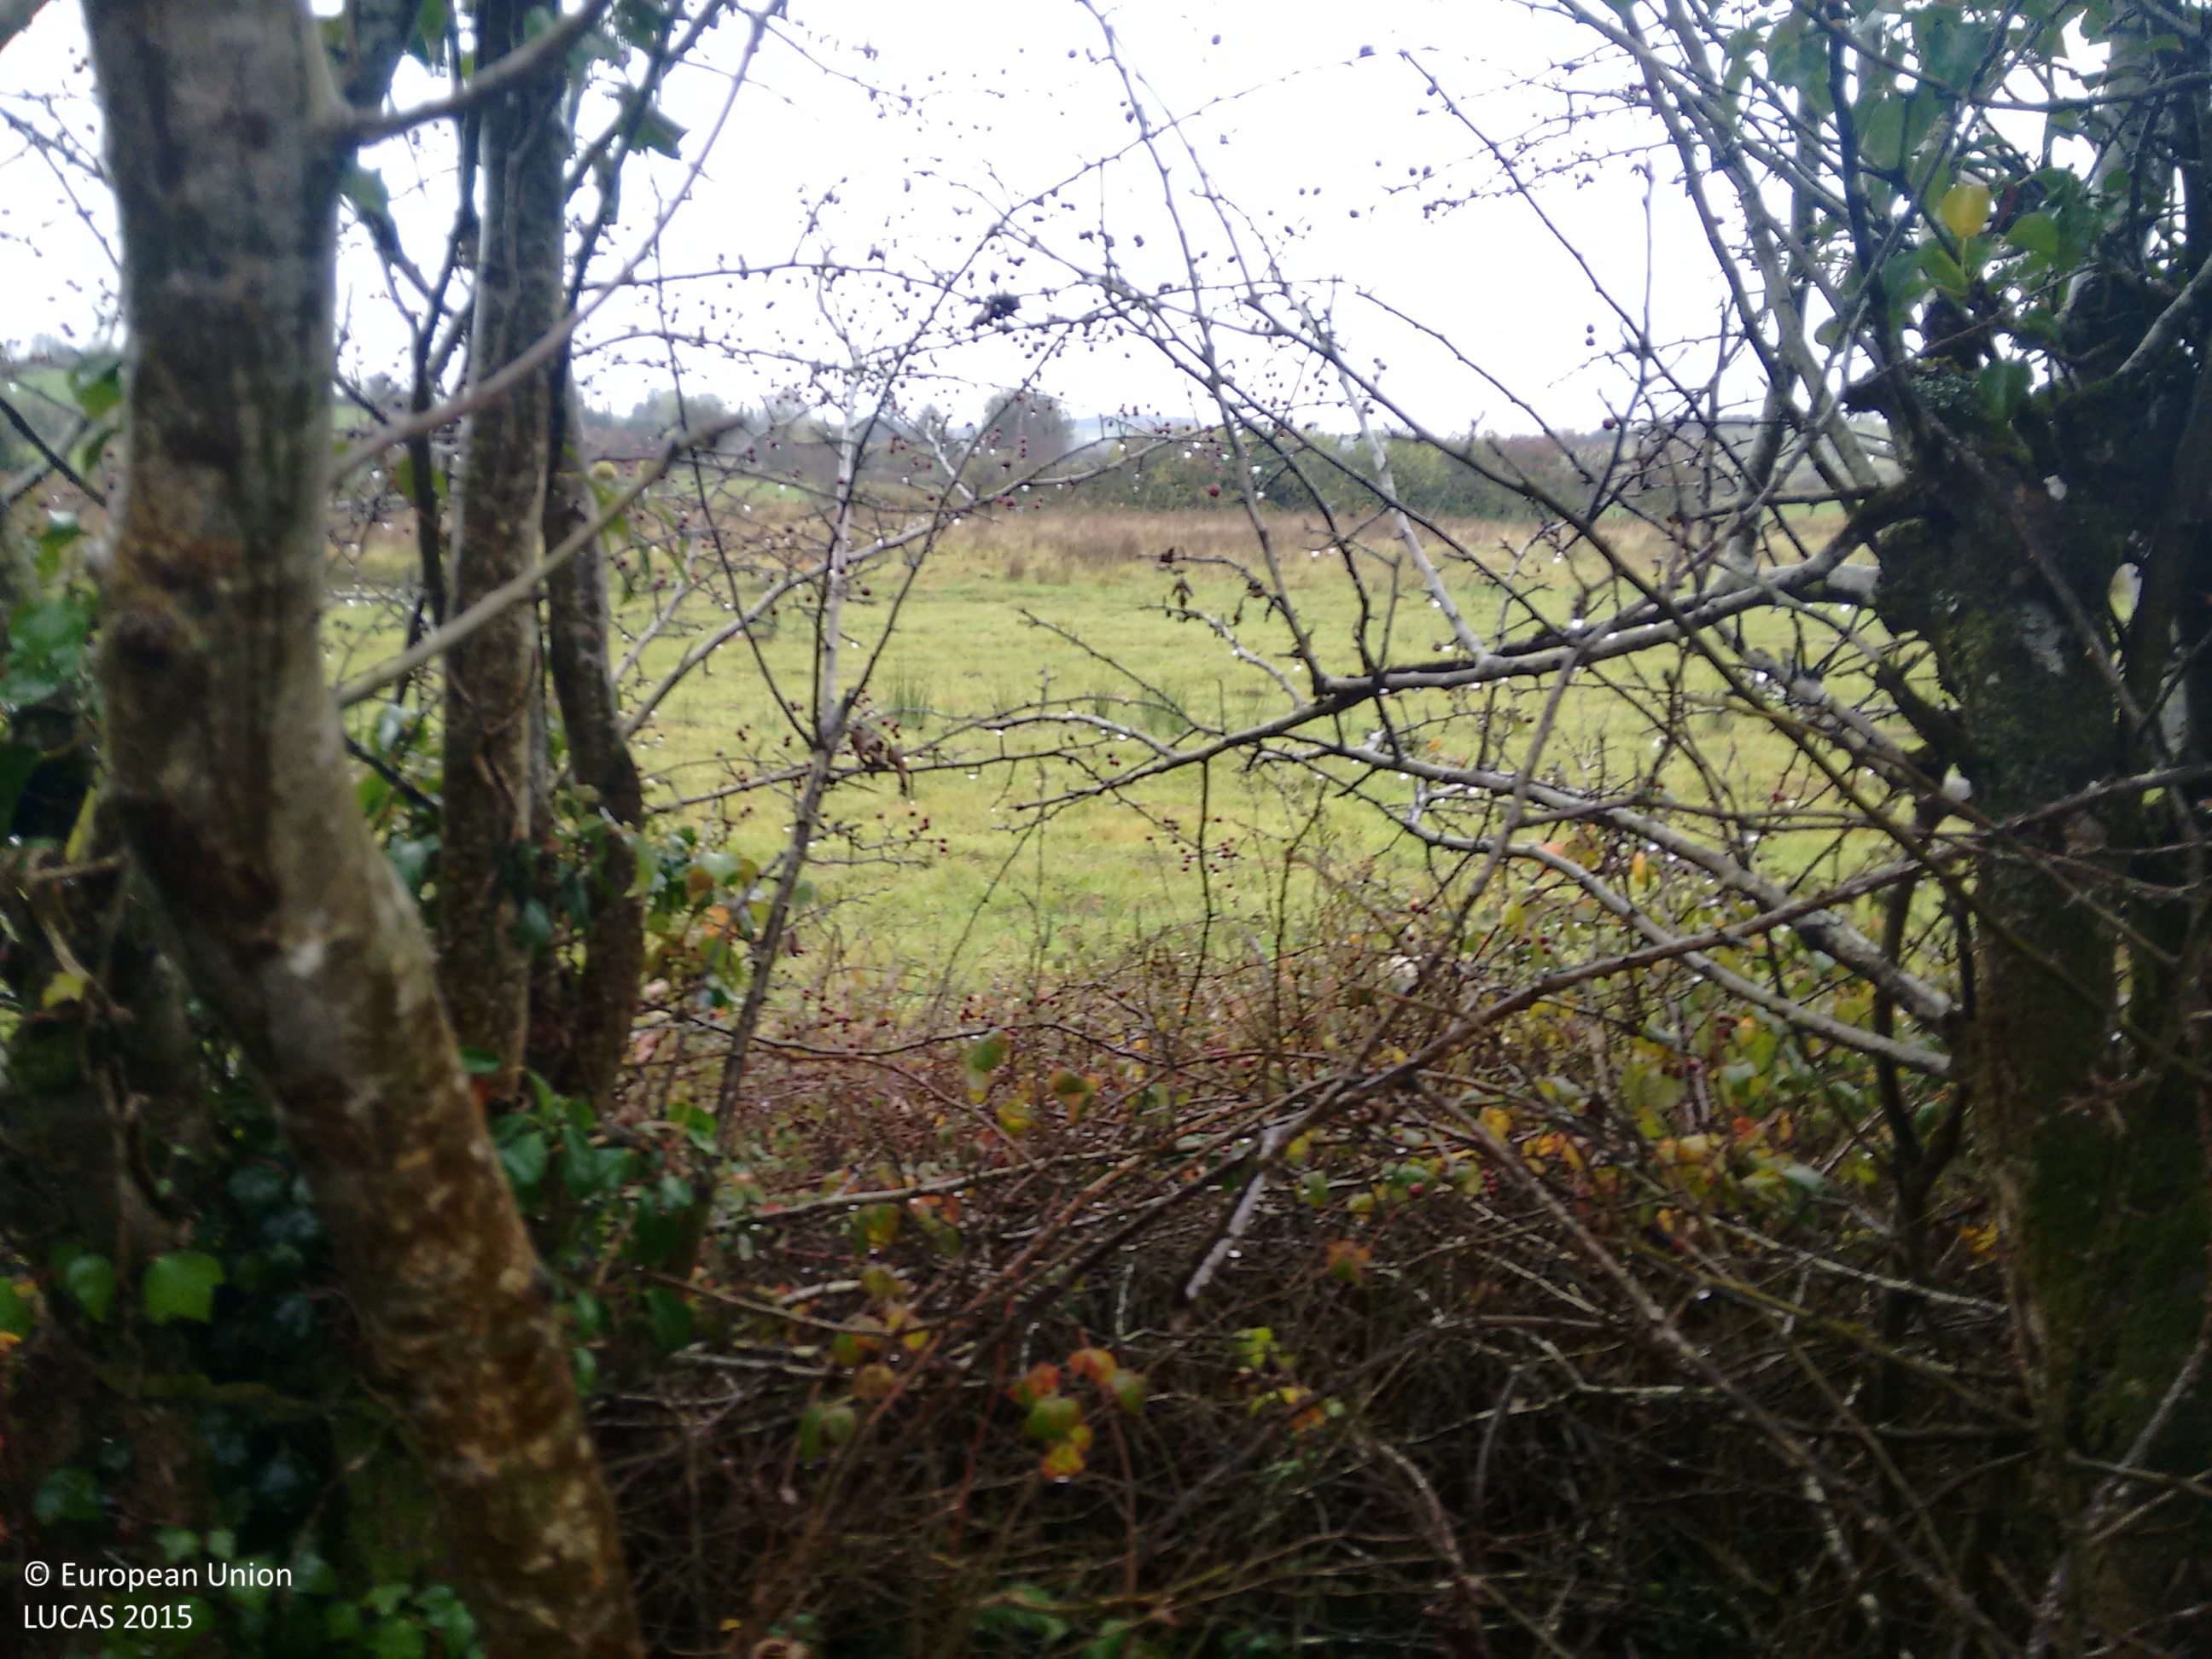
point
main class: Grassland
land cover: Grassland without tree/shrub cover
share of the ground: > 75 %
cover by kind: herbaceous plants 100 %
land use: Agriculture (excluding fallow land and kitchen gardens)
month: October
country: IE
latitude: 53.8833
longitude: -8.1148
